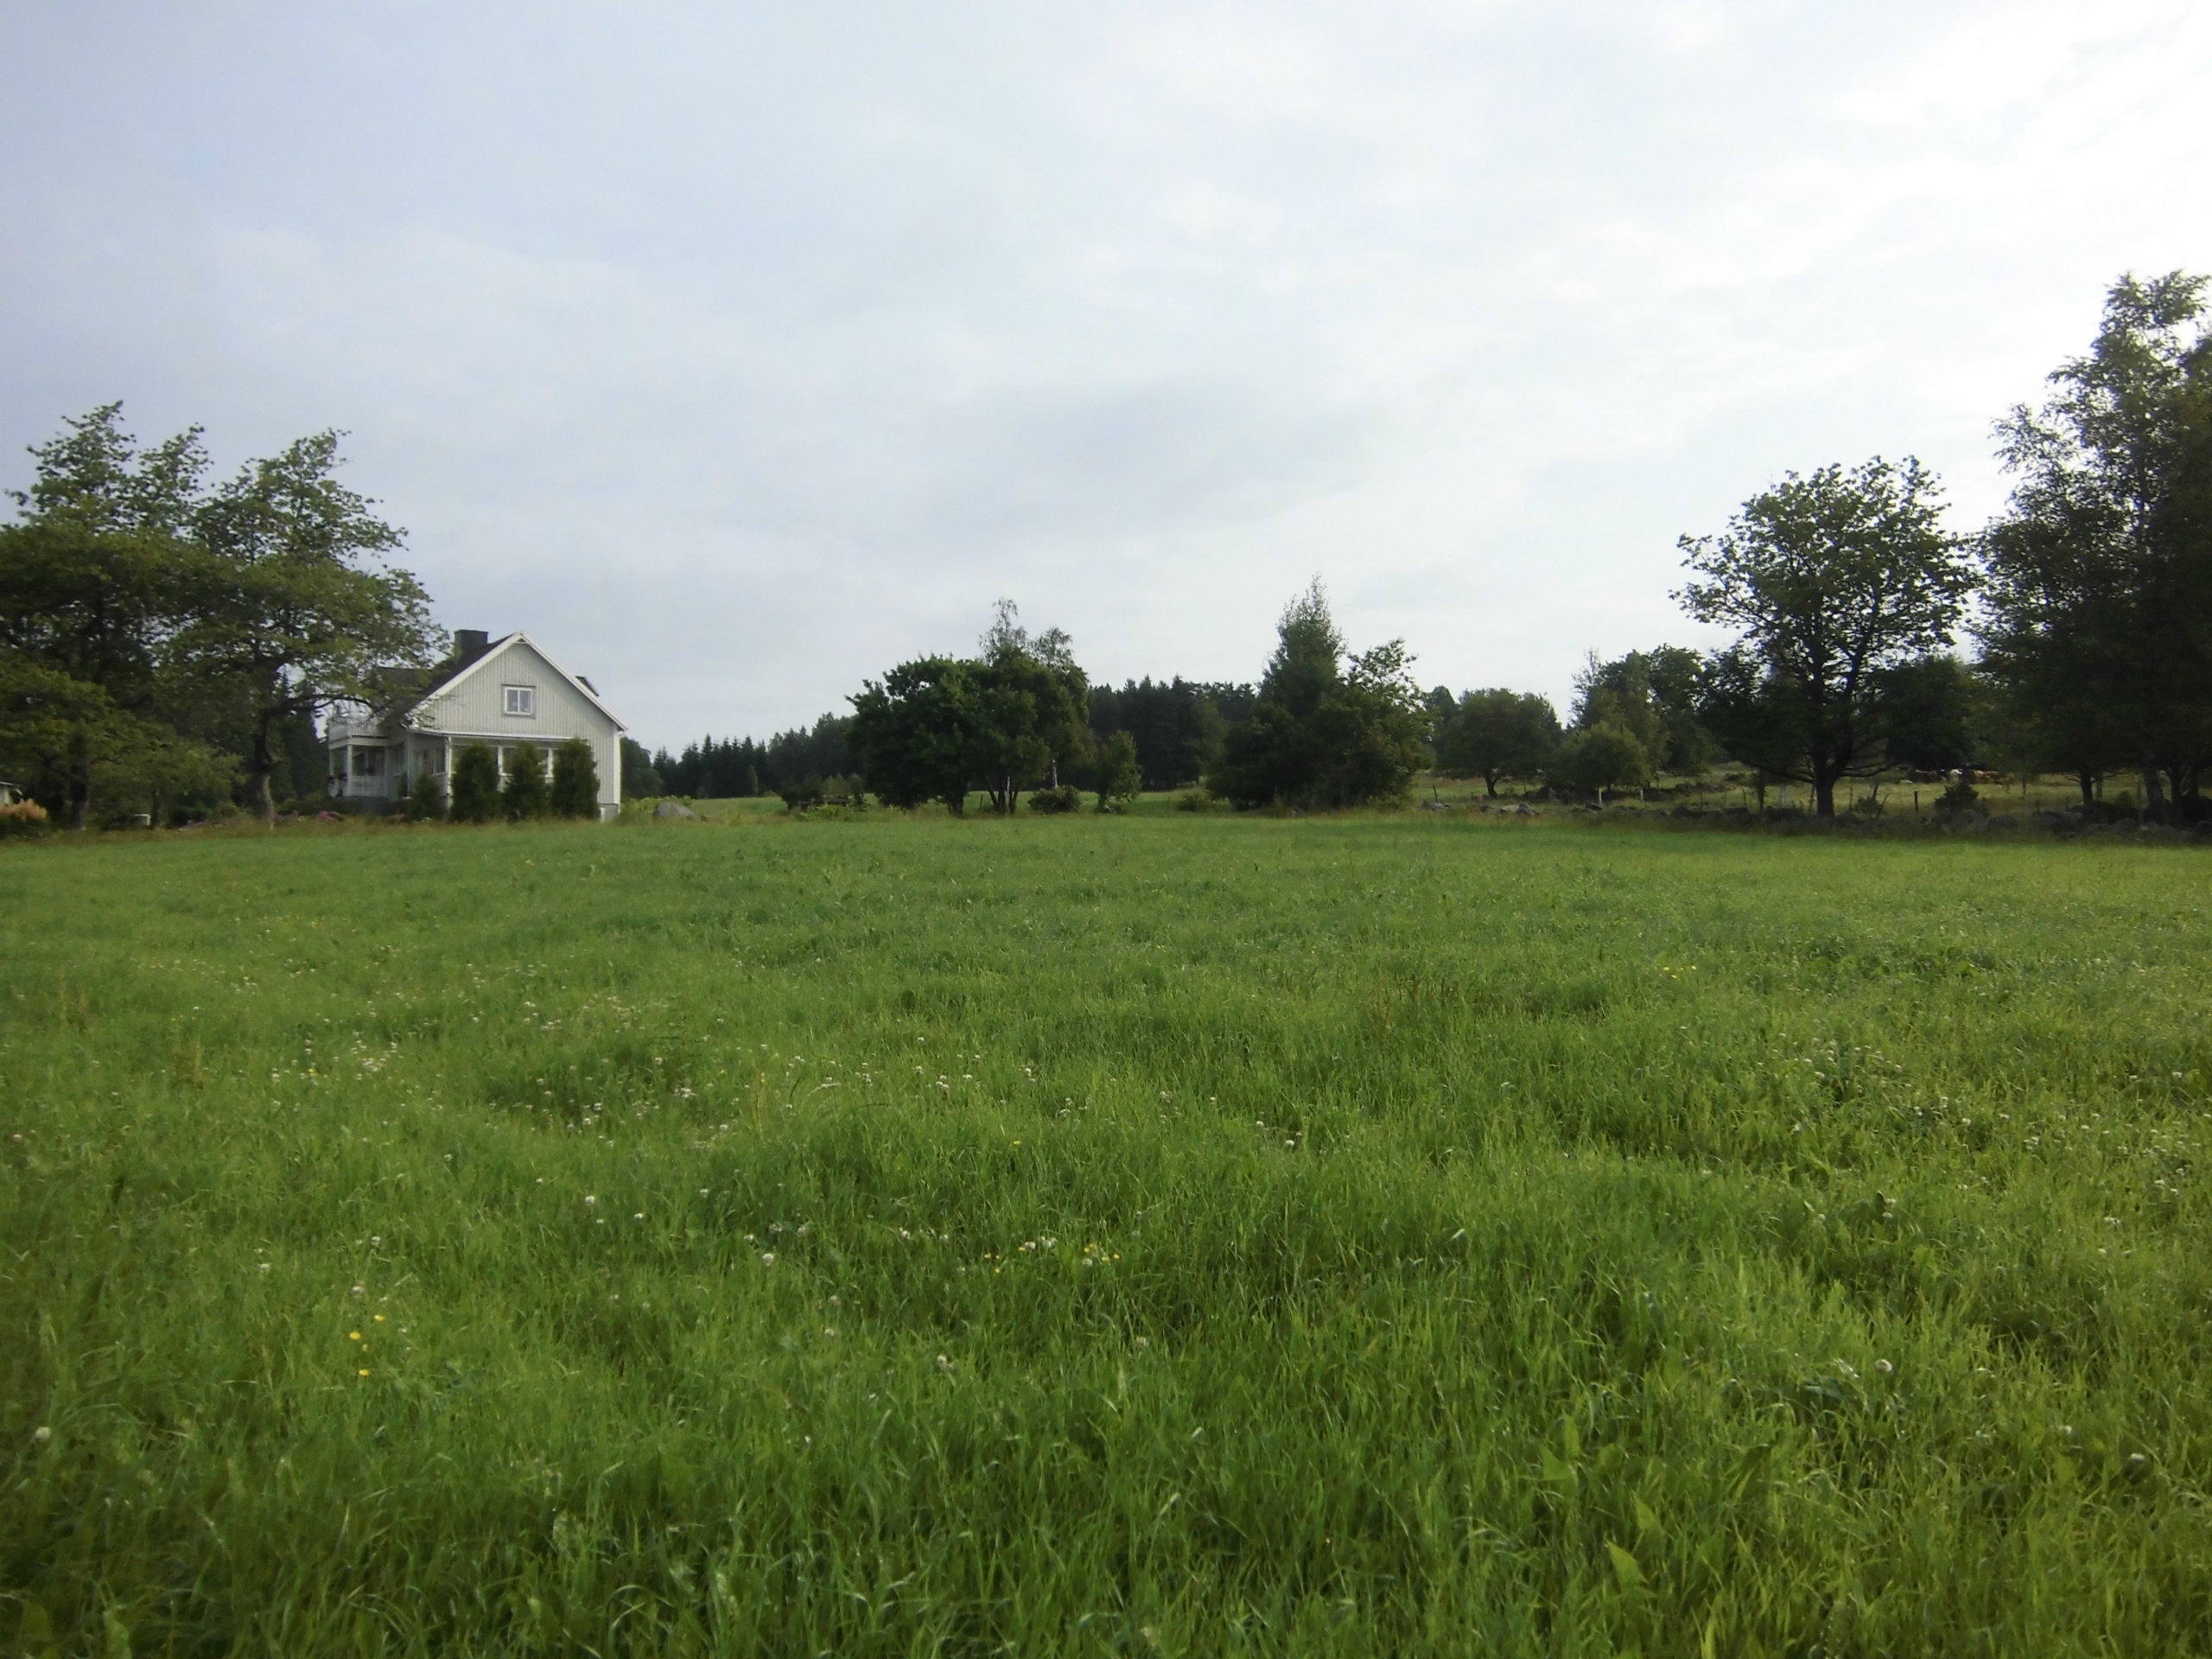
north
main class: Grassland
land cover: Grassland without tree/shrub cover
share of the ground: > 75 %
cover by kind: herbaceous plants 100 %
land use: Agriculture (excluding fallow land and kitchen gardens)
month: July
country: SE
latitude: 57.4308
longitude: 14.8095
